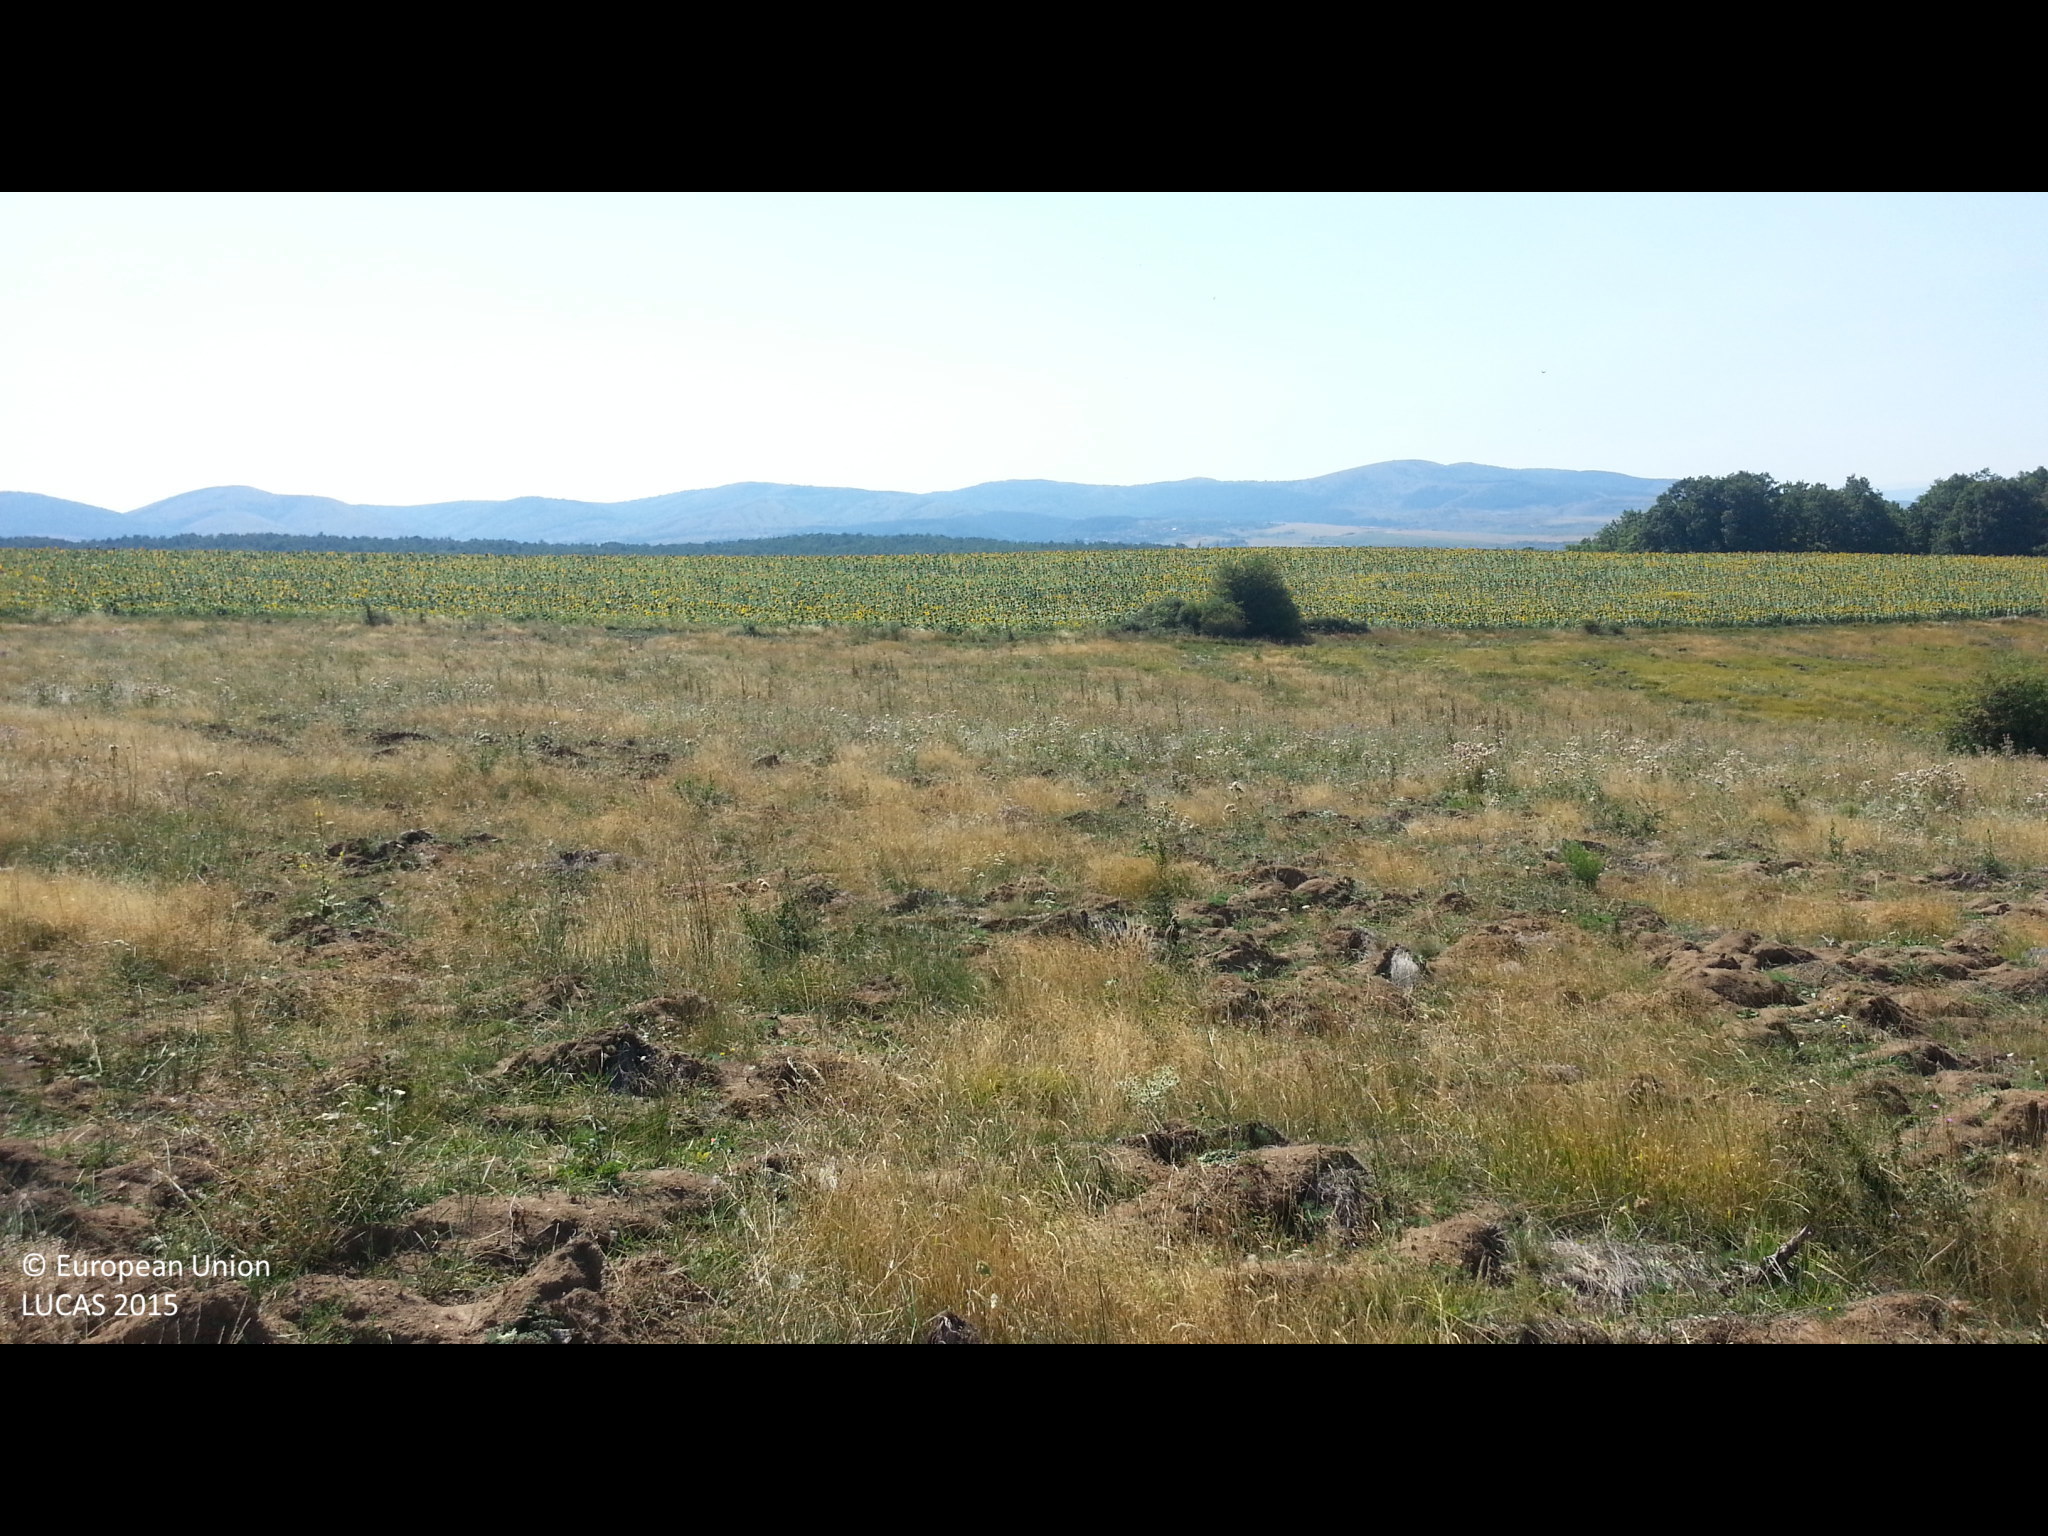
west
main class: Grassland
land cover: Spontaneously vegetated surfaces
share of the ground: 50 - 75 %
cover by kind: herbaceous plants 70 %, unconsolidated bare surface 30 %
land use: Fallow land
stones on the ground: < 10 %
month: August
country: BG
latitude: 42.5779
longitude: 23.1525
